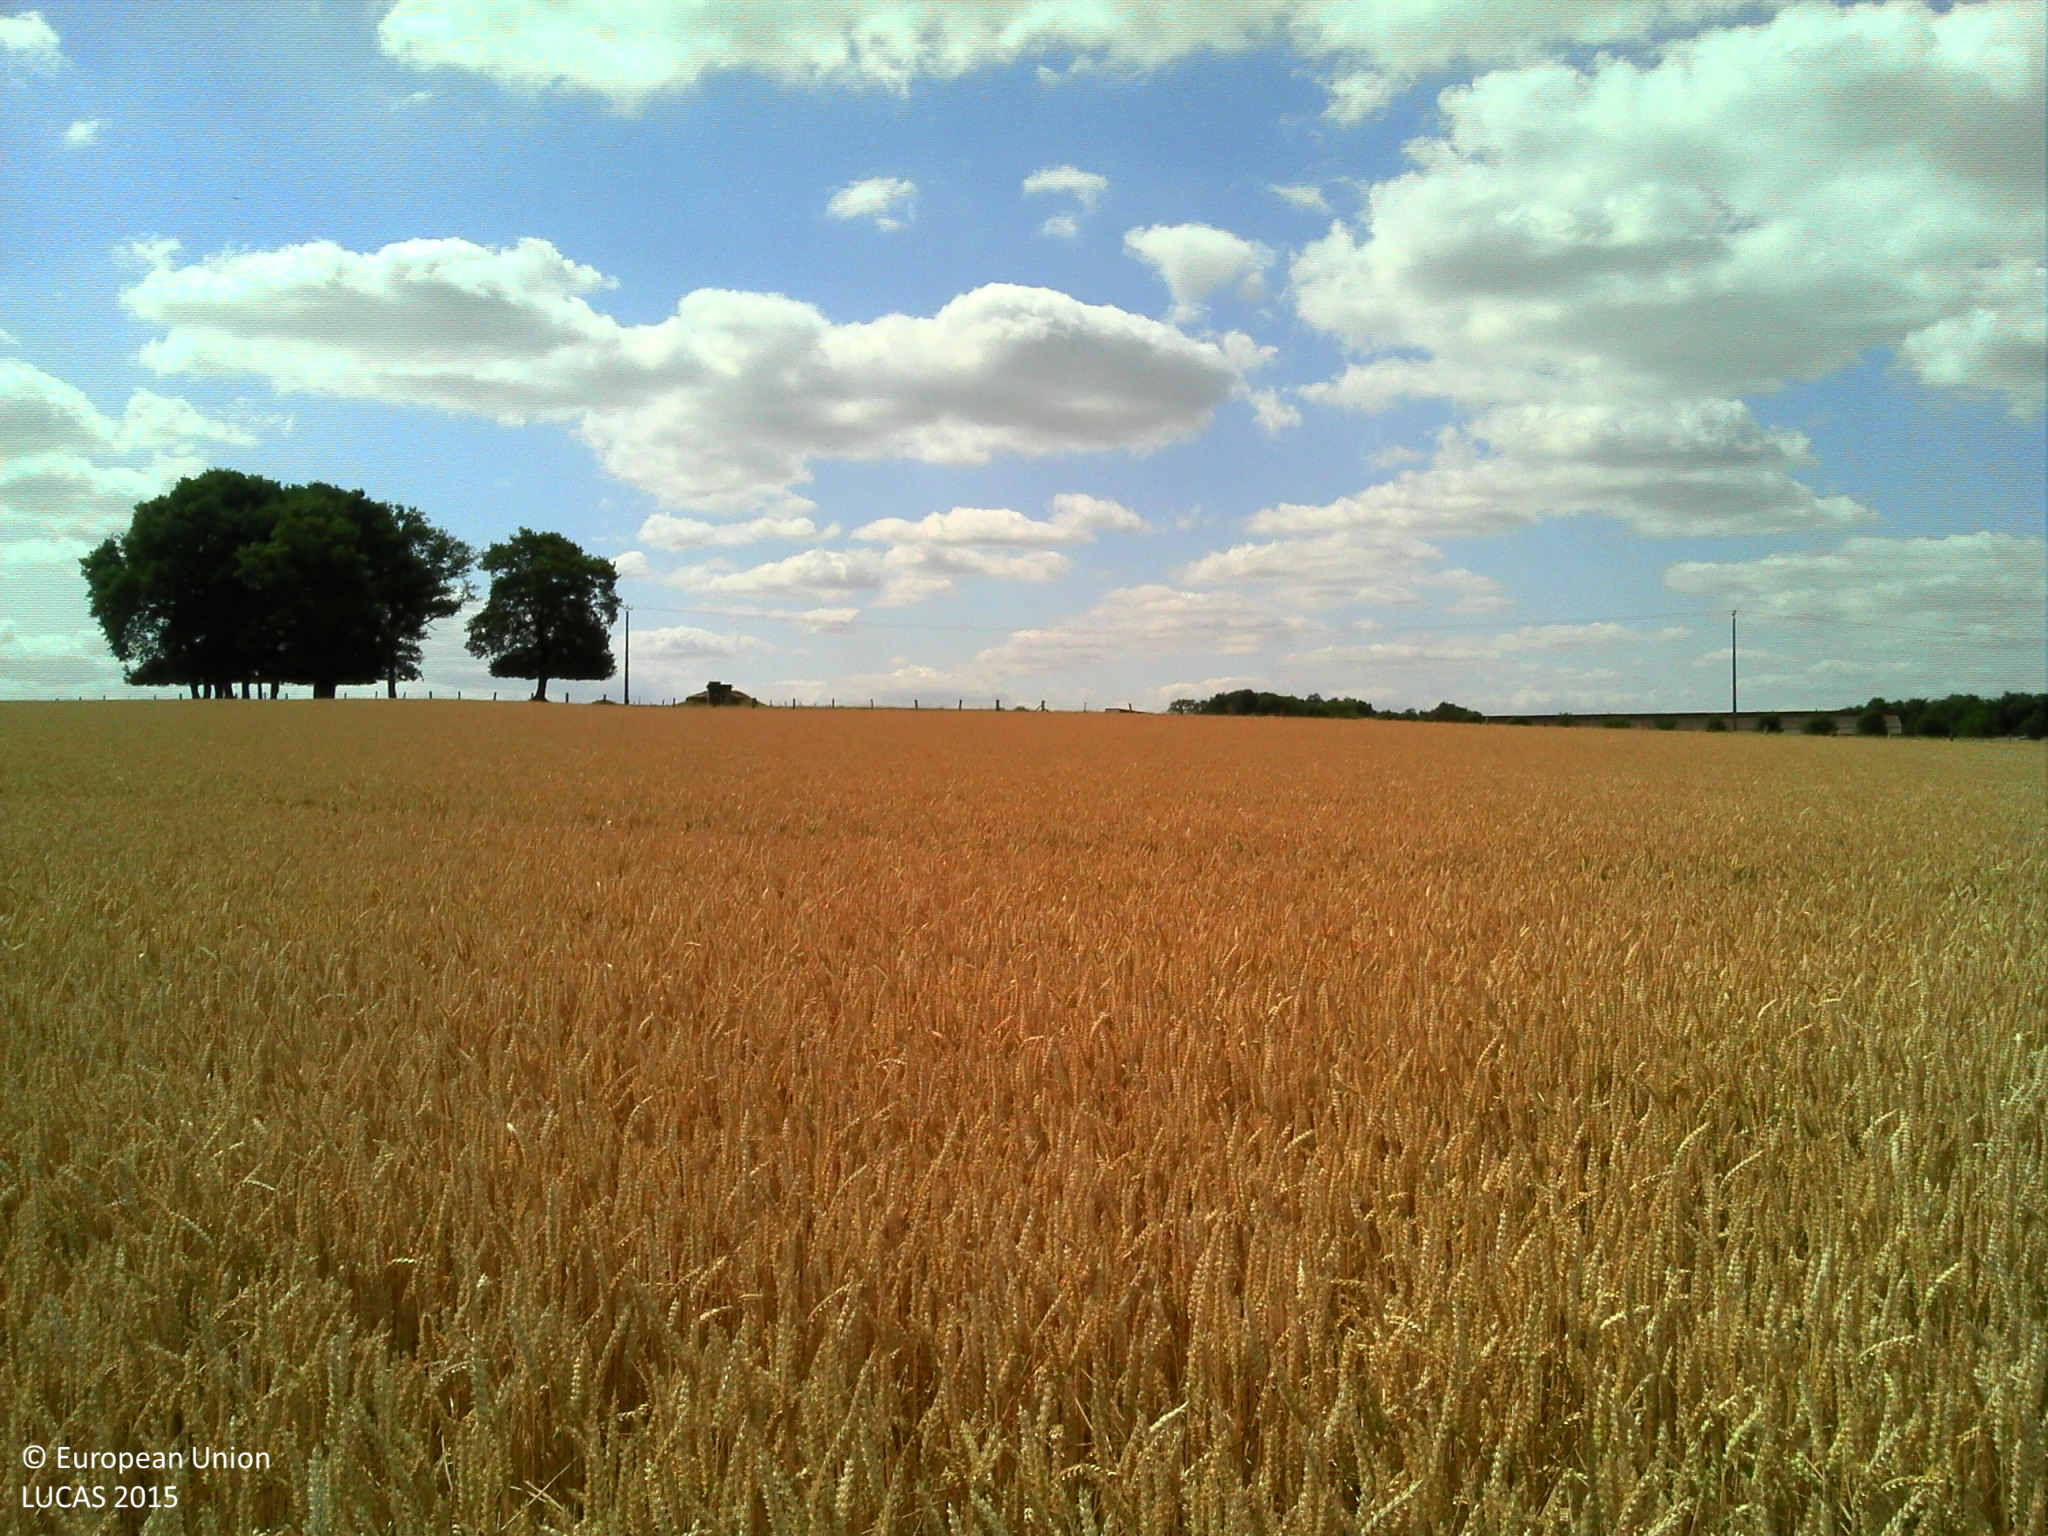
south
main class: Cropland
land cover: Common wheat
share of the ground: > 75 %
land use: Agriculture (excluding fallow land and kitchen gardens)
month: July
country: FR
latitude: 49.3299
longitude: 1.8242
